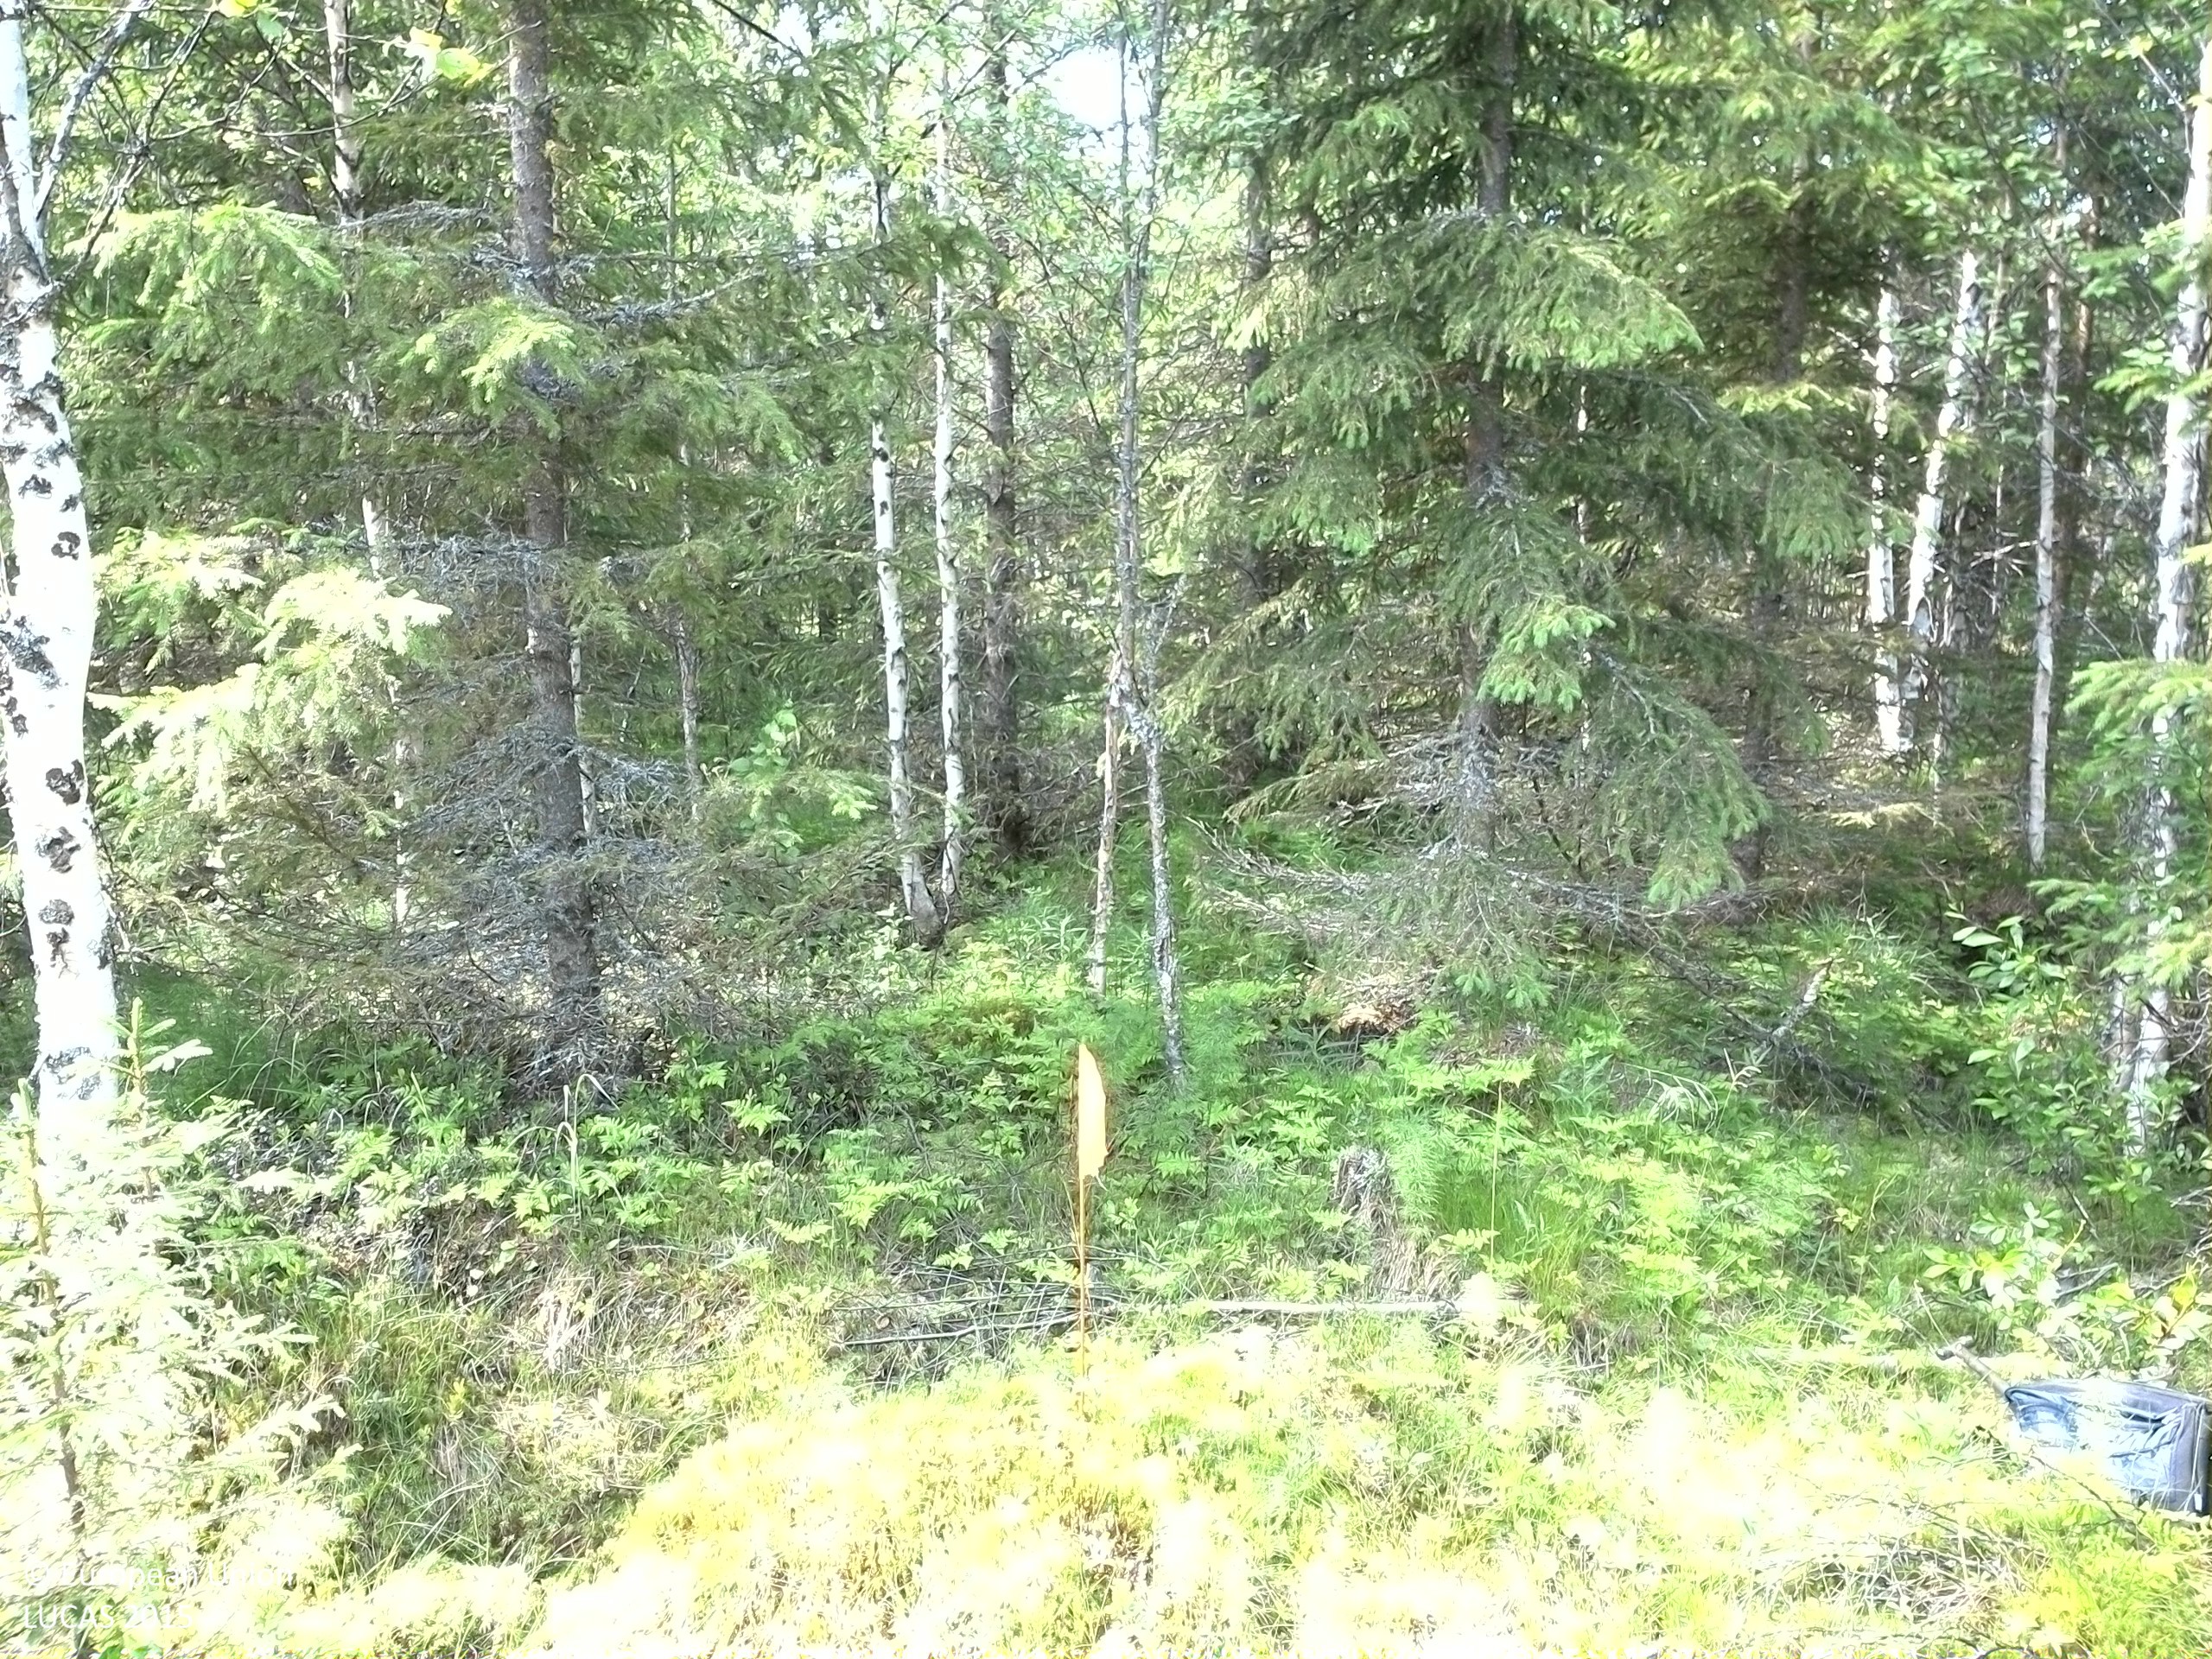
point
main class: Woodland
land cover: Spruce dominated mixed woodland
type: boreal forest
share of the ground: > 75 %
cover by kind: coniferous forest trees 45 %, broadleaved forest trees 25 %, herbaceous plants 15 %, lichens and mosses 10 %, shrubs 5 %
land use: Forestry
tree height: > 5 m
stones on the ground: 25 - 50 %
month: July
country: SE
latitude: 63.5683
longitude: 17.4842
